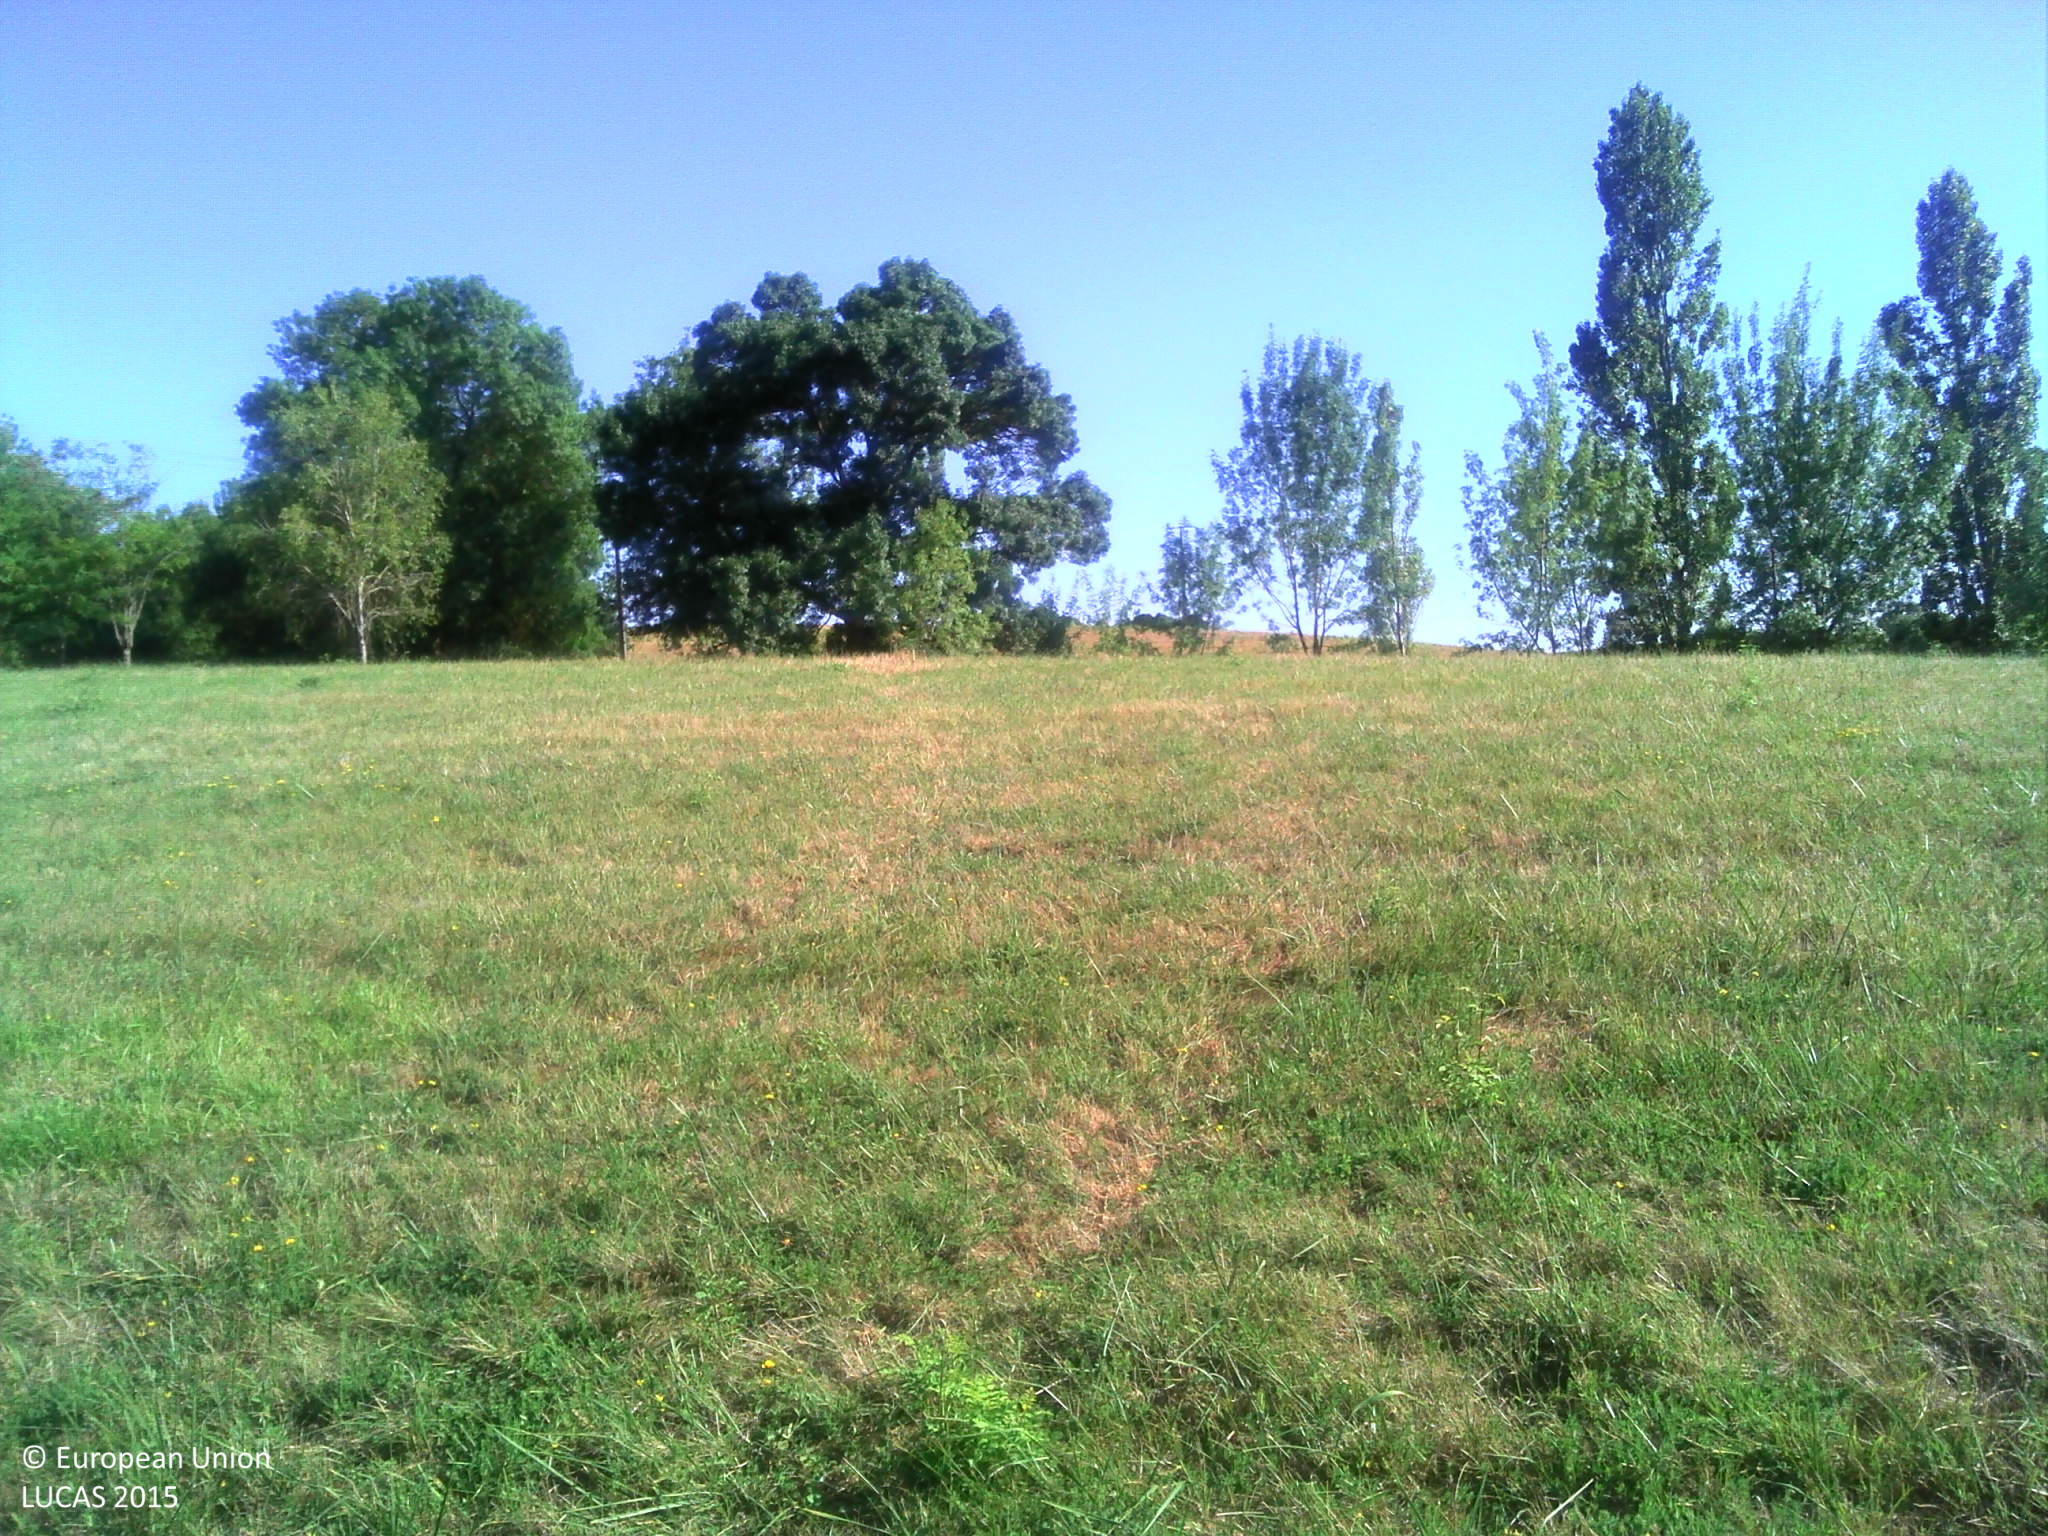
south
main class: Grassland
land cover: Grassland without tree/shrub cover
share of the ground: > 75 %
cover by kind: herbaceous plants 95 %, shrubs 5 %
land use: Agriculture (excluding fallow land and kitchen gardens)
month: July
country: FR
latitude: 43.8397
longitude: 0.6815
